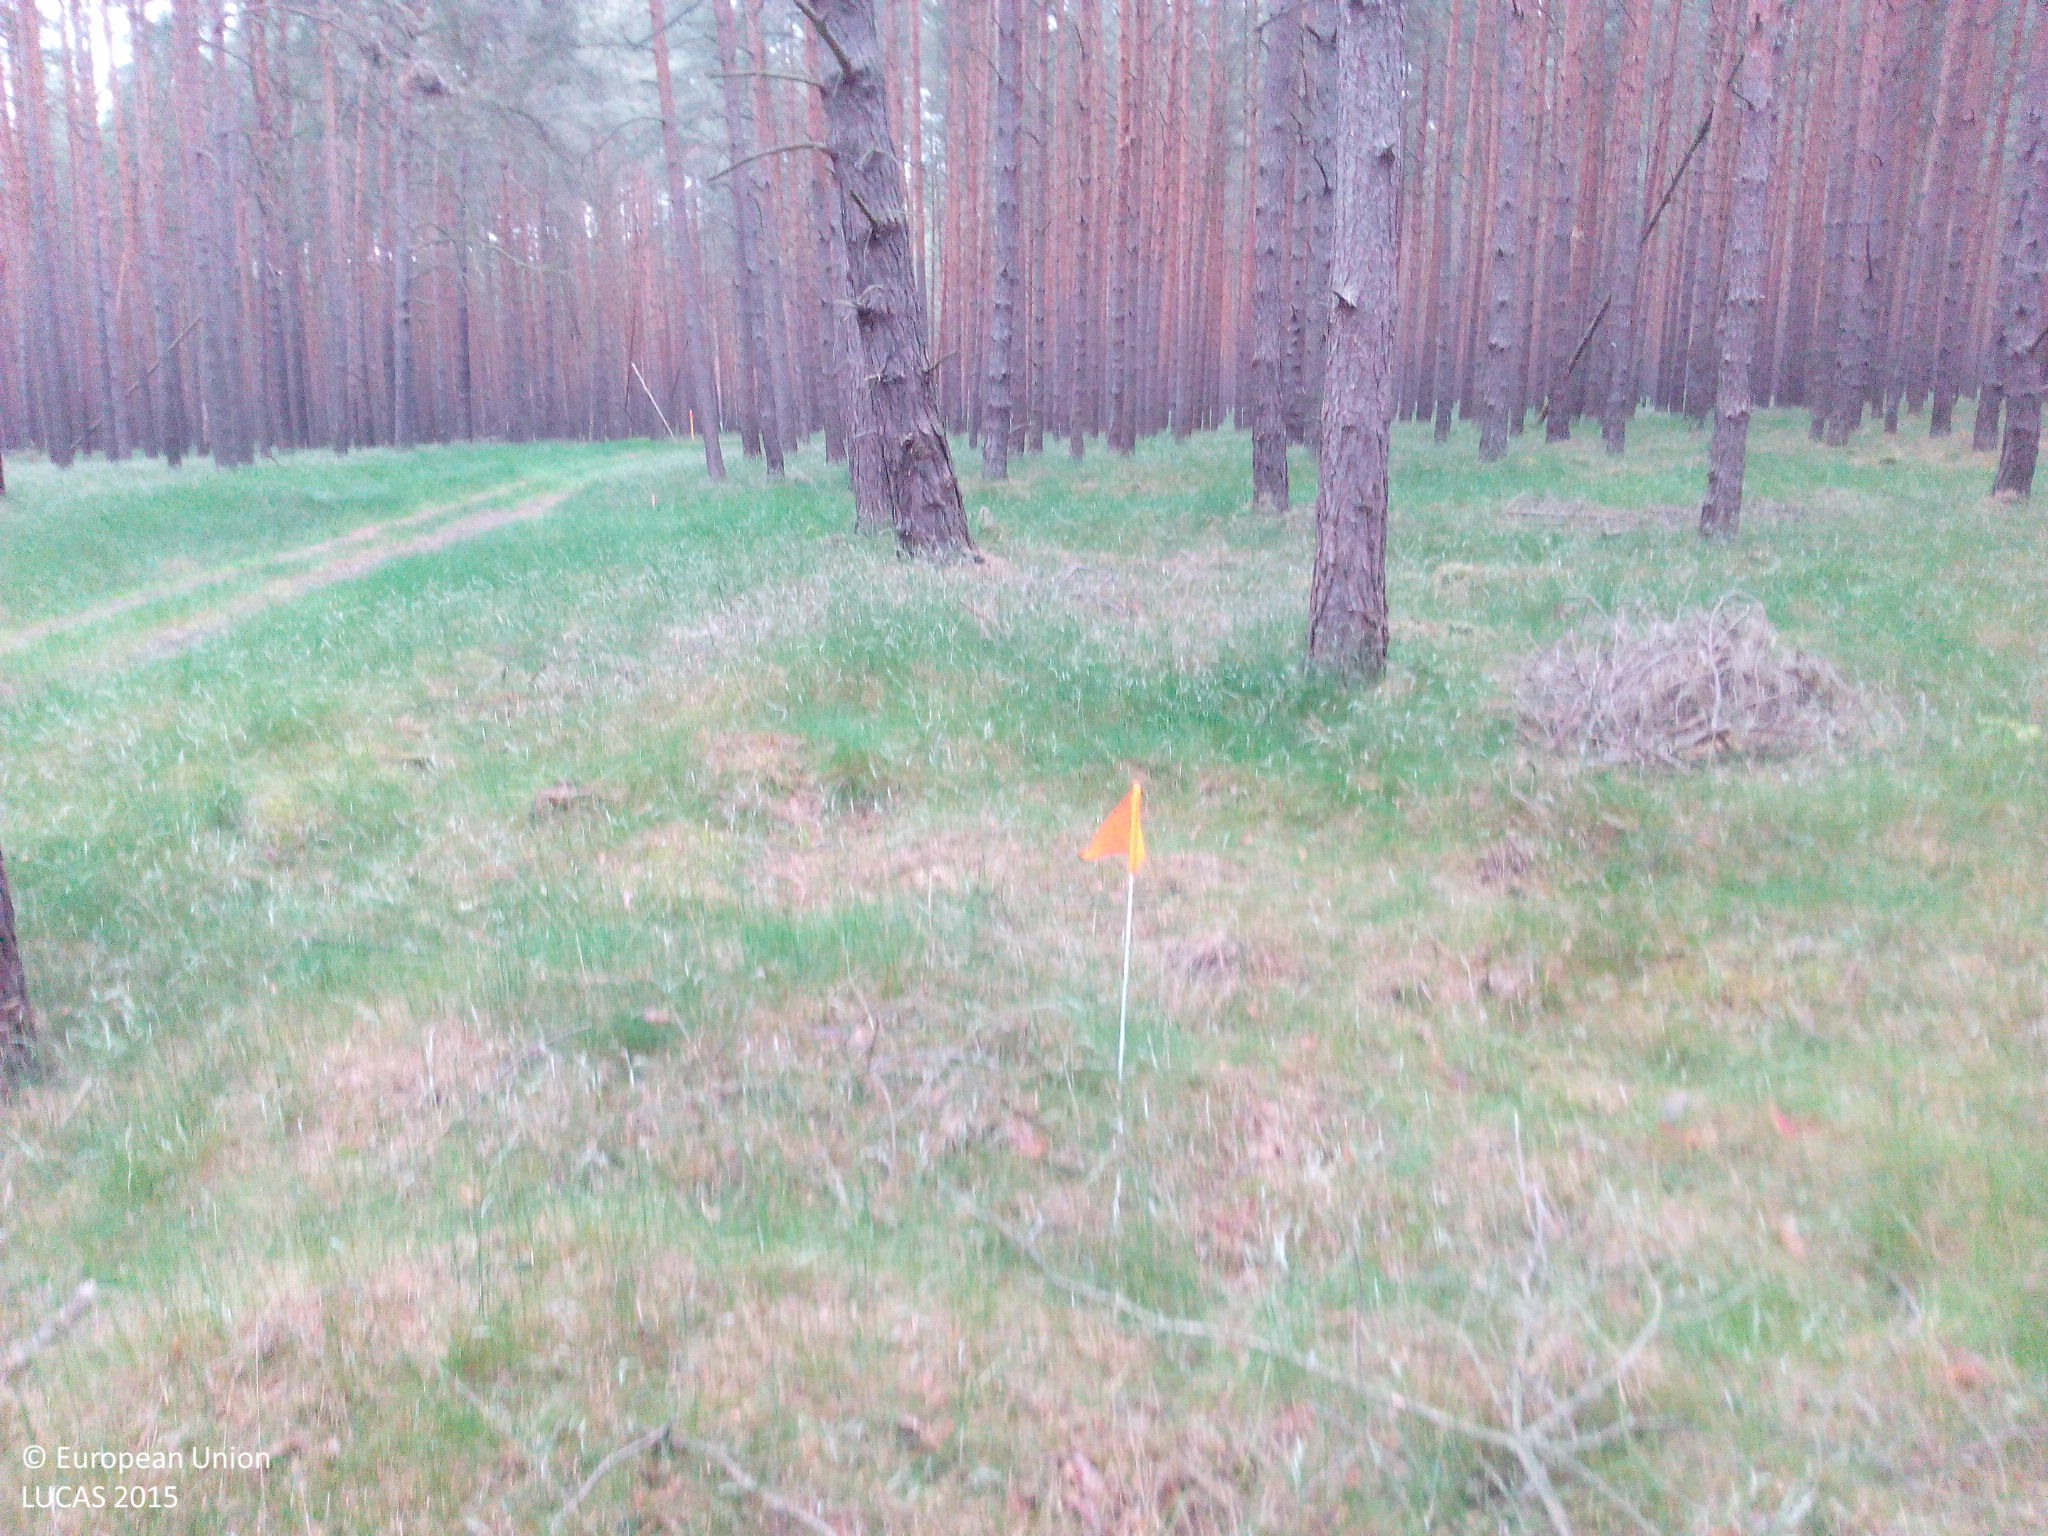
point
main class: Woodland
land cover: Pine dominated coniferous woodland
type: hemiboreal forest and nemoral coniferous forest and mixed broadleaved-coniferous forest
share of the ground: > 75 %
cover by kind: coniferous forest trees 90 %, herbaceous plants 5 %, lichens and mosses 5 %
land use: Forestry
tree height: > 5 m
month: June
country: DE
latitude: 52.3132
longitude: 12.5960
